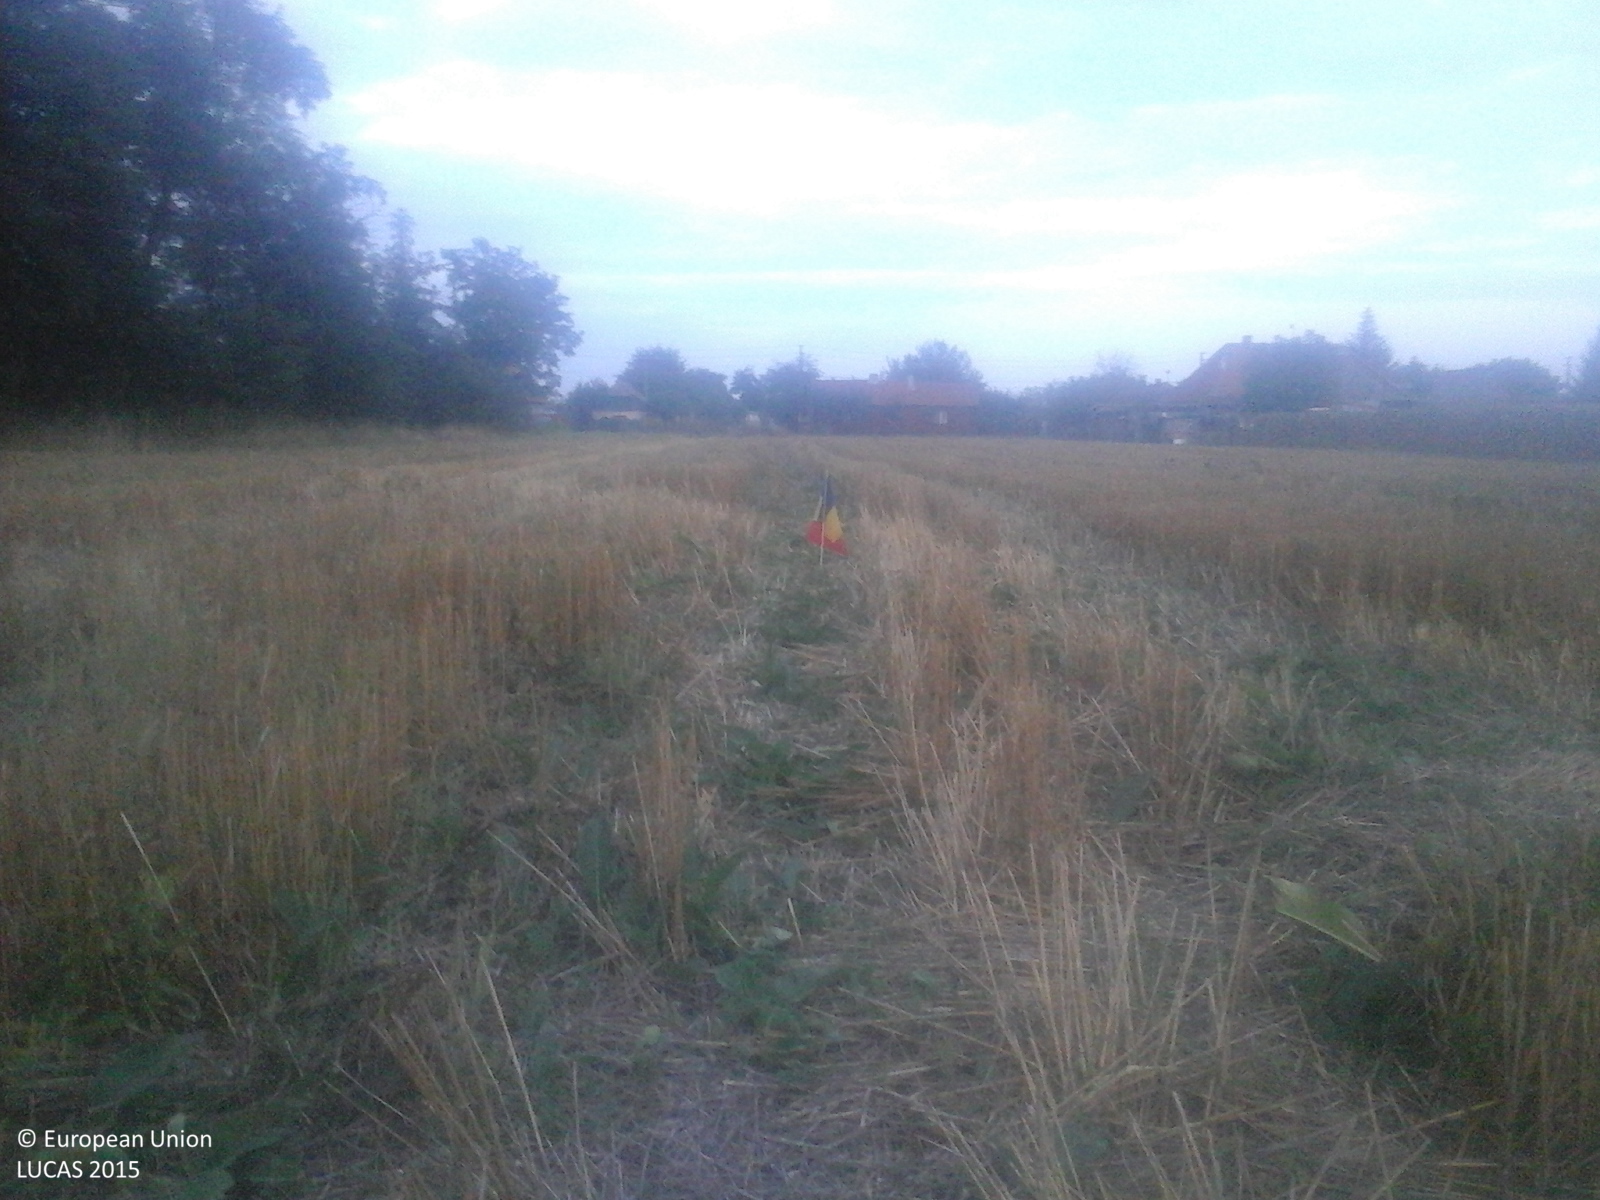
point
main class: Cropland
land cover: Durum wheat
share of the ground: > 75 %
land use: Agriculture (excluding fallow land and kitchen gardens)
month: September
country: RO
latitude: 47.8123
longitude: 22.7085
